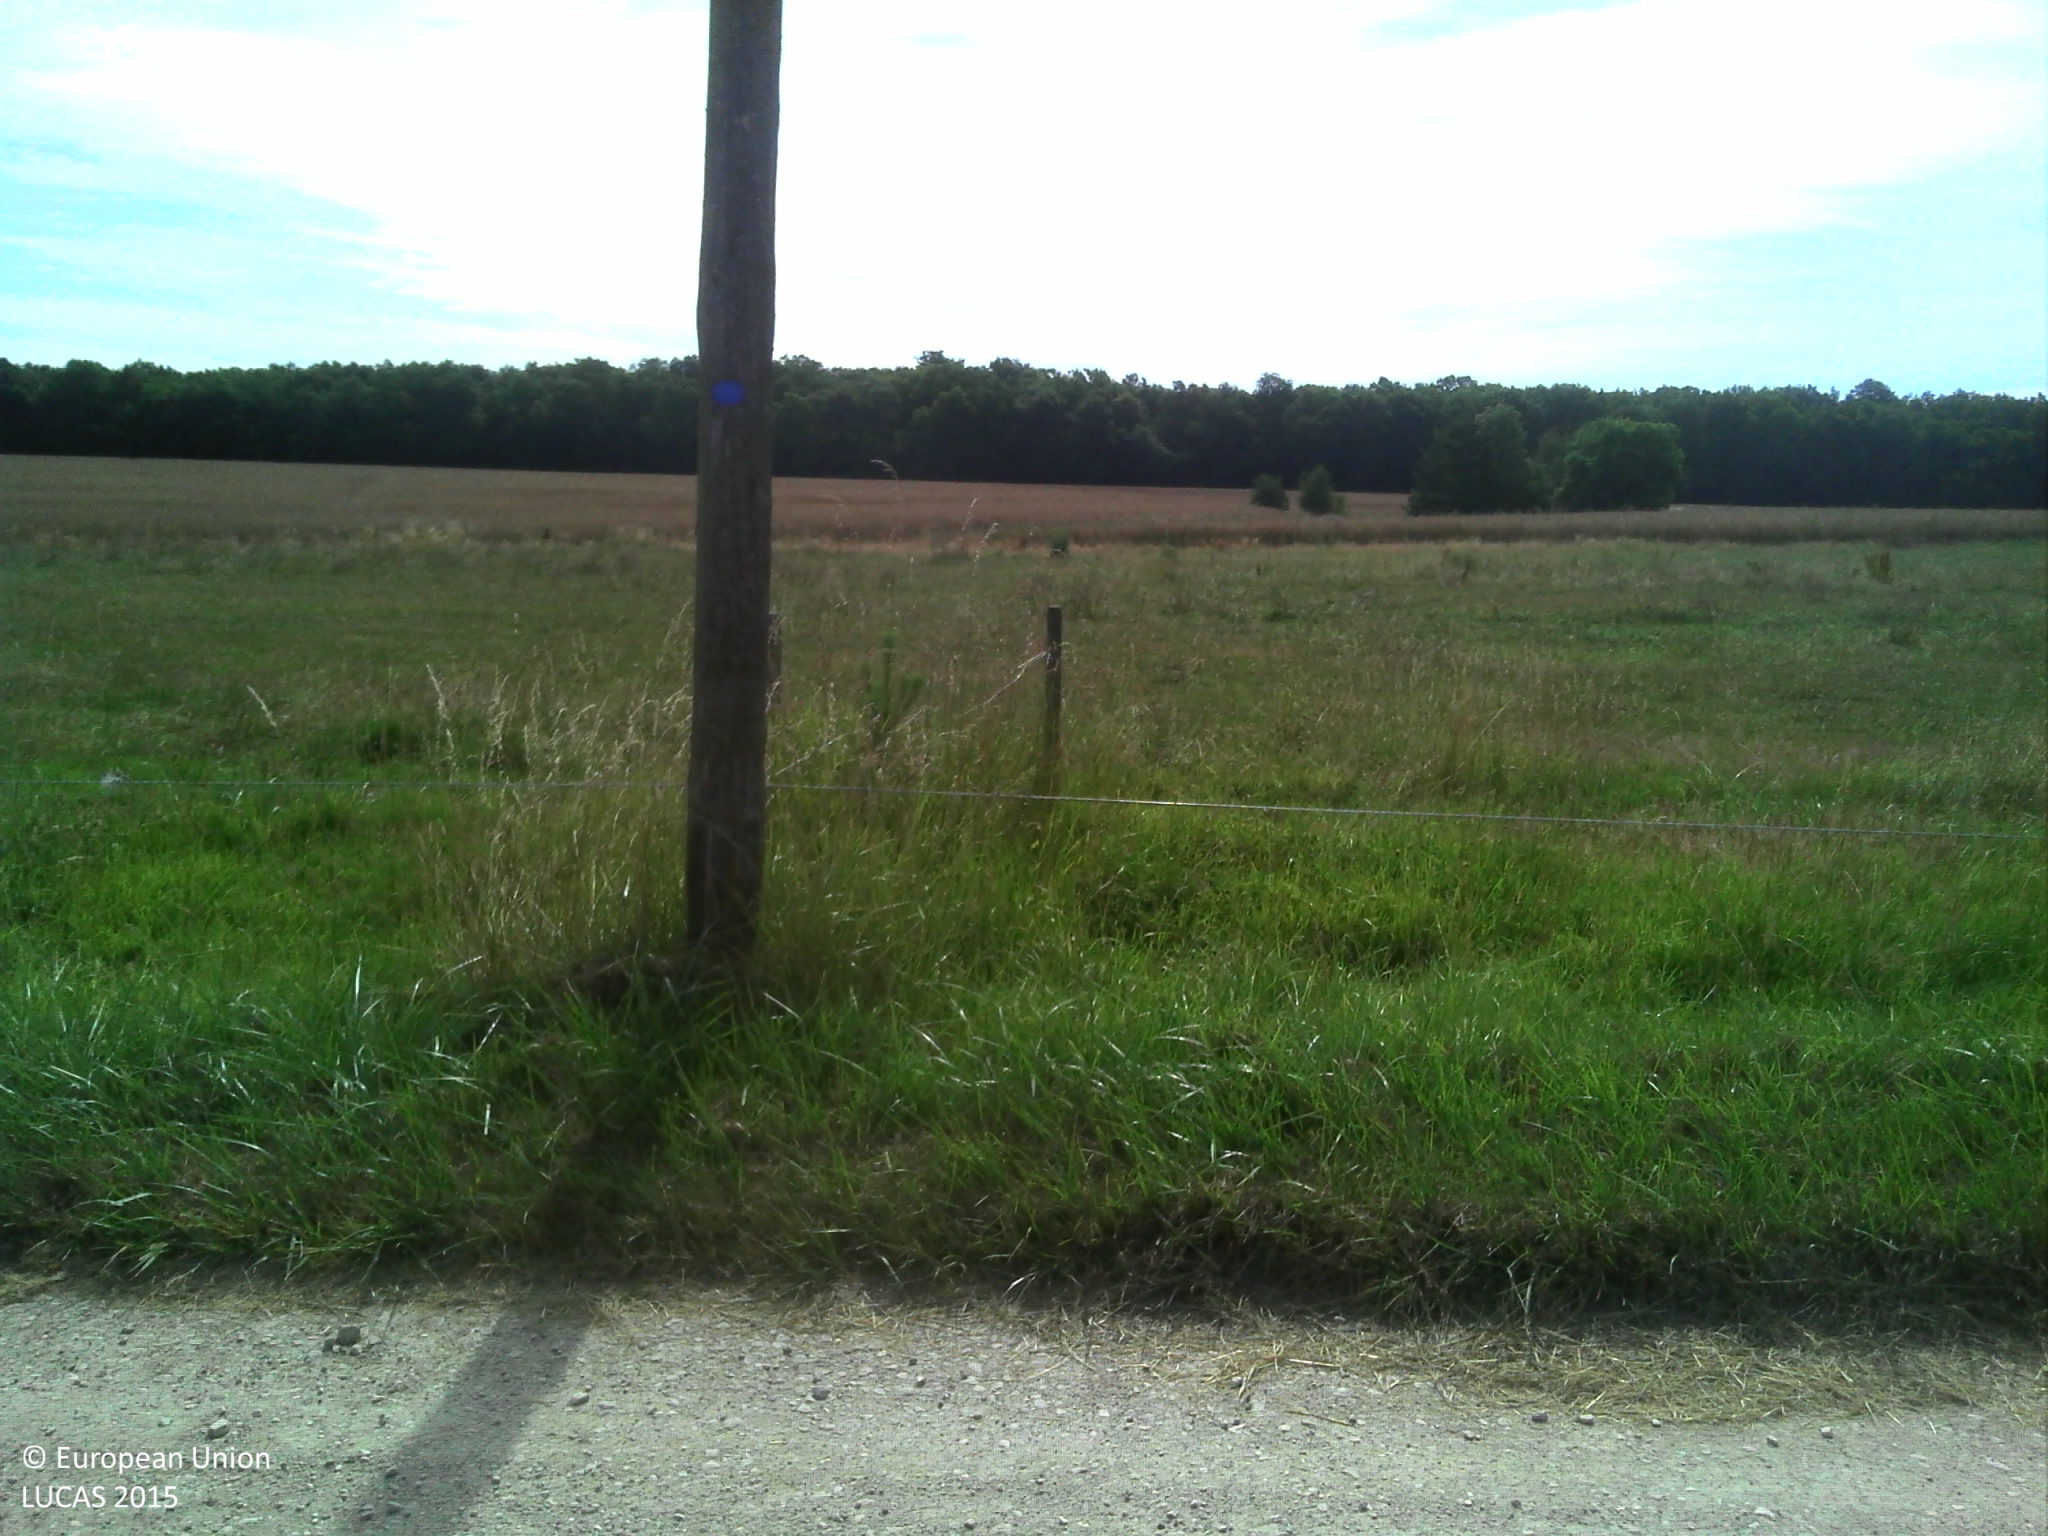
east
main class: Cropland
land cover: Rape and turnip rape
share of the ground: > 75 %
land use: Agriculture (excluding fallow land and kitchen gardens)
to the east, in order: Rape and turnip rape; Grass margins; Tracks; Grass margins; Electric lines; Fences; Grassland without tree/shrub cover; Fences; Grassland without tree/shrub cover; Ditches and canals; Grassland without tree/shrub cover
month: June
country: FR
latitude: 46.7111
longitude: 4.7820
